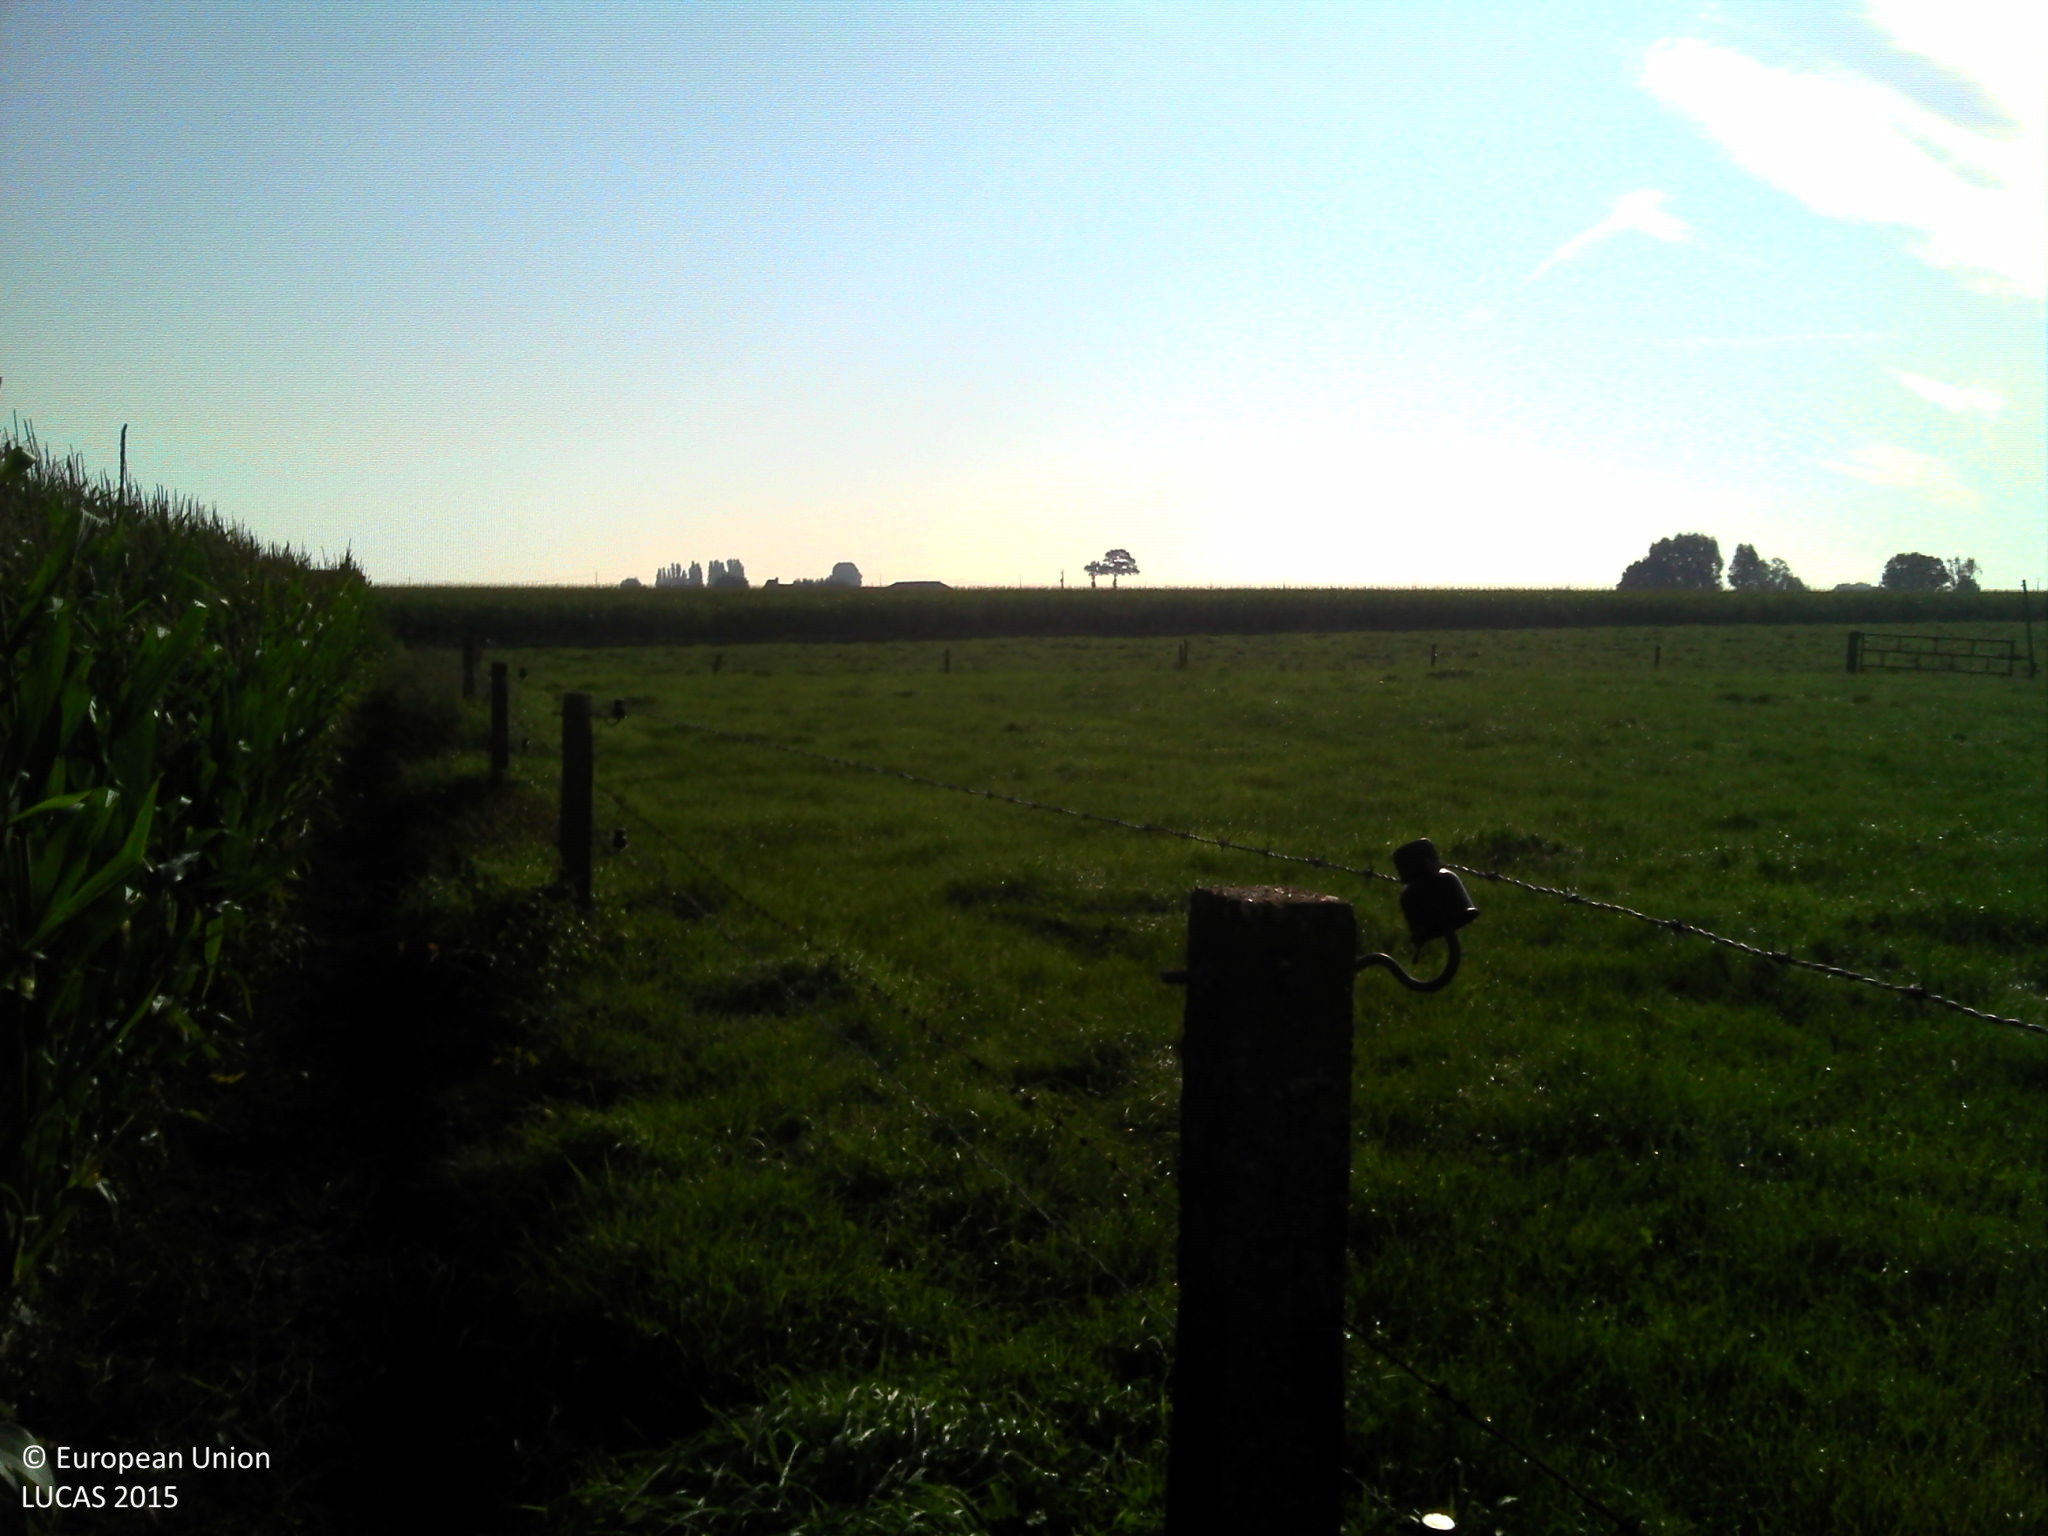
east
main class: Cropland
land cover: Maize
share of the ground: > 75 %
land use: Agriculture (excluding fallow land and kitchen gardens)
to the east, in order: Fences; Grassland without tree/shrub cover; Fences; Grassland without tree/shrub cover; Fences; Grass margins; Maize; Other fibre and oleaginous crops
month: September
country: BE
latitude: 50.9977
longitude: 2.7071
